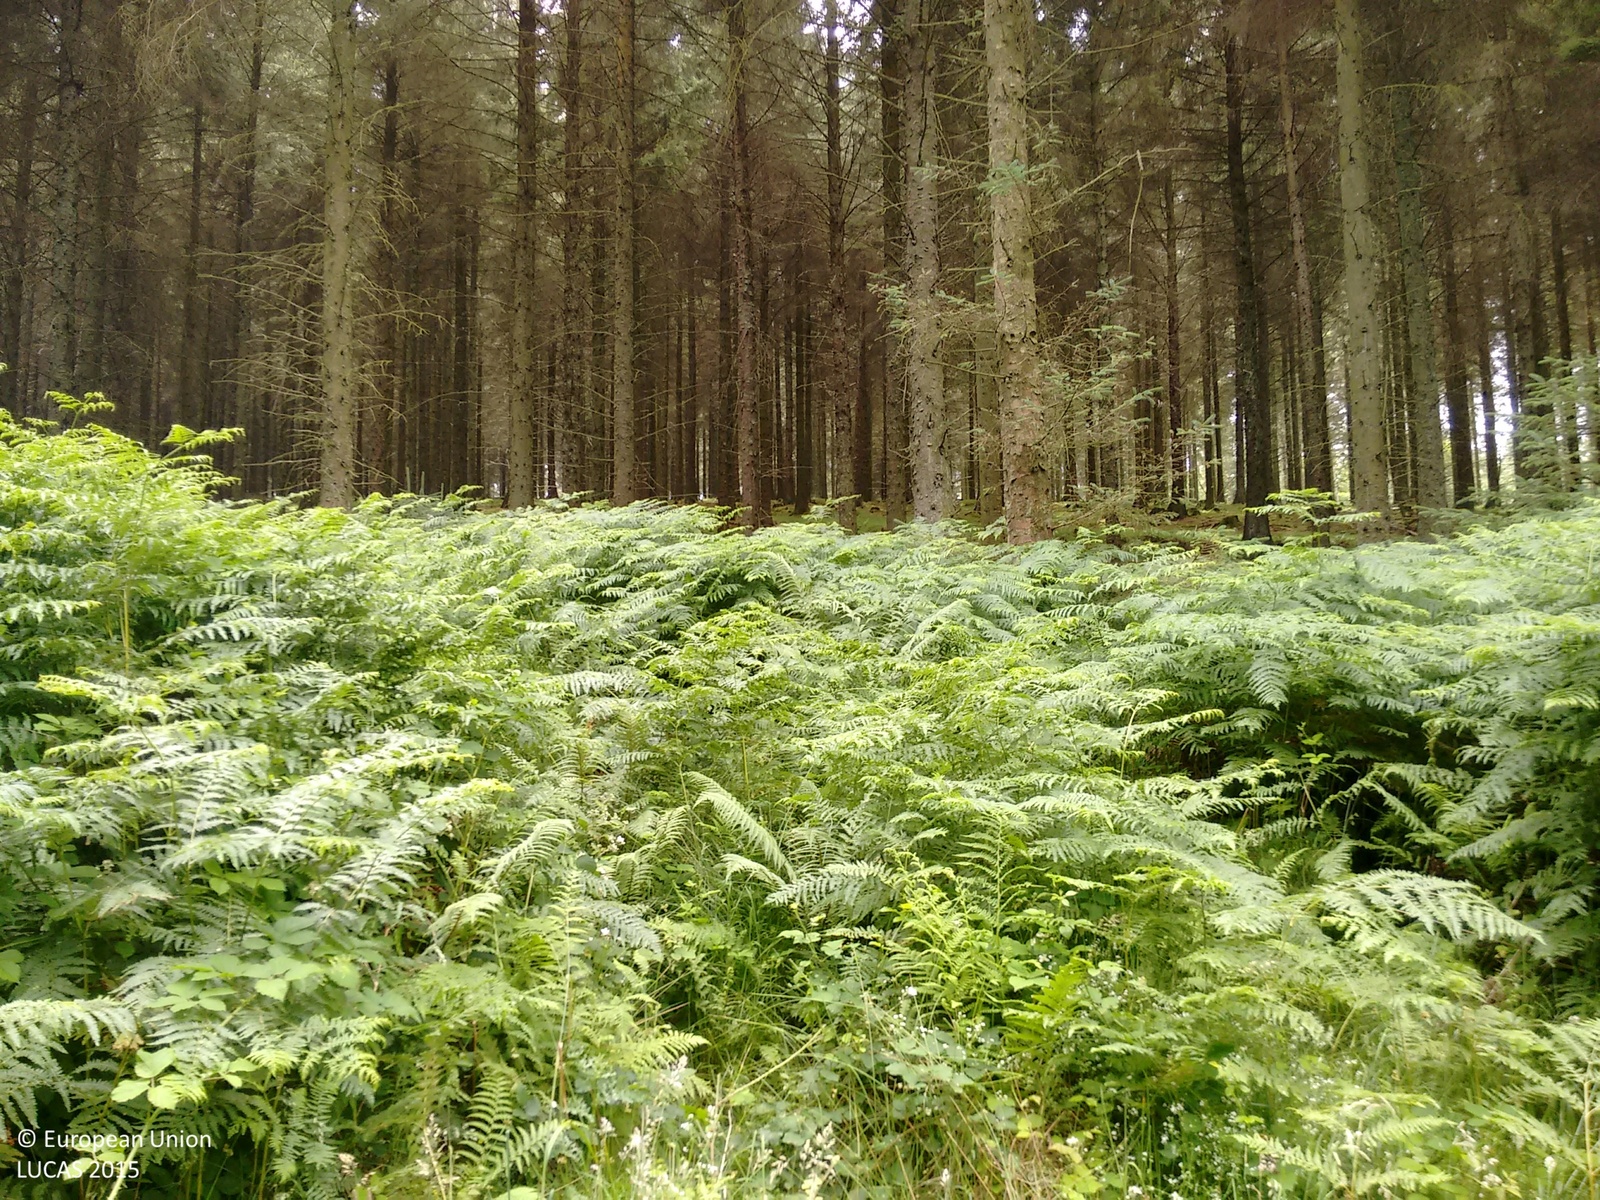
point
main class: Woodland
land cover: Spruce dominated coniferous woodland
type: exotic forest
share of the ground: > 75 %
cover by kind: coniferous forest trees 100 %
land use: Forestry
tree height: > 5 m
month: July
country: GB
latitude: 51.3200
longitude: -2.7698
